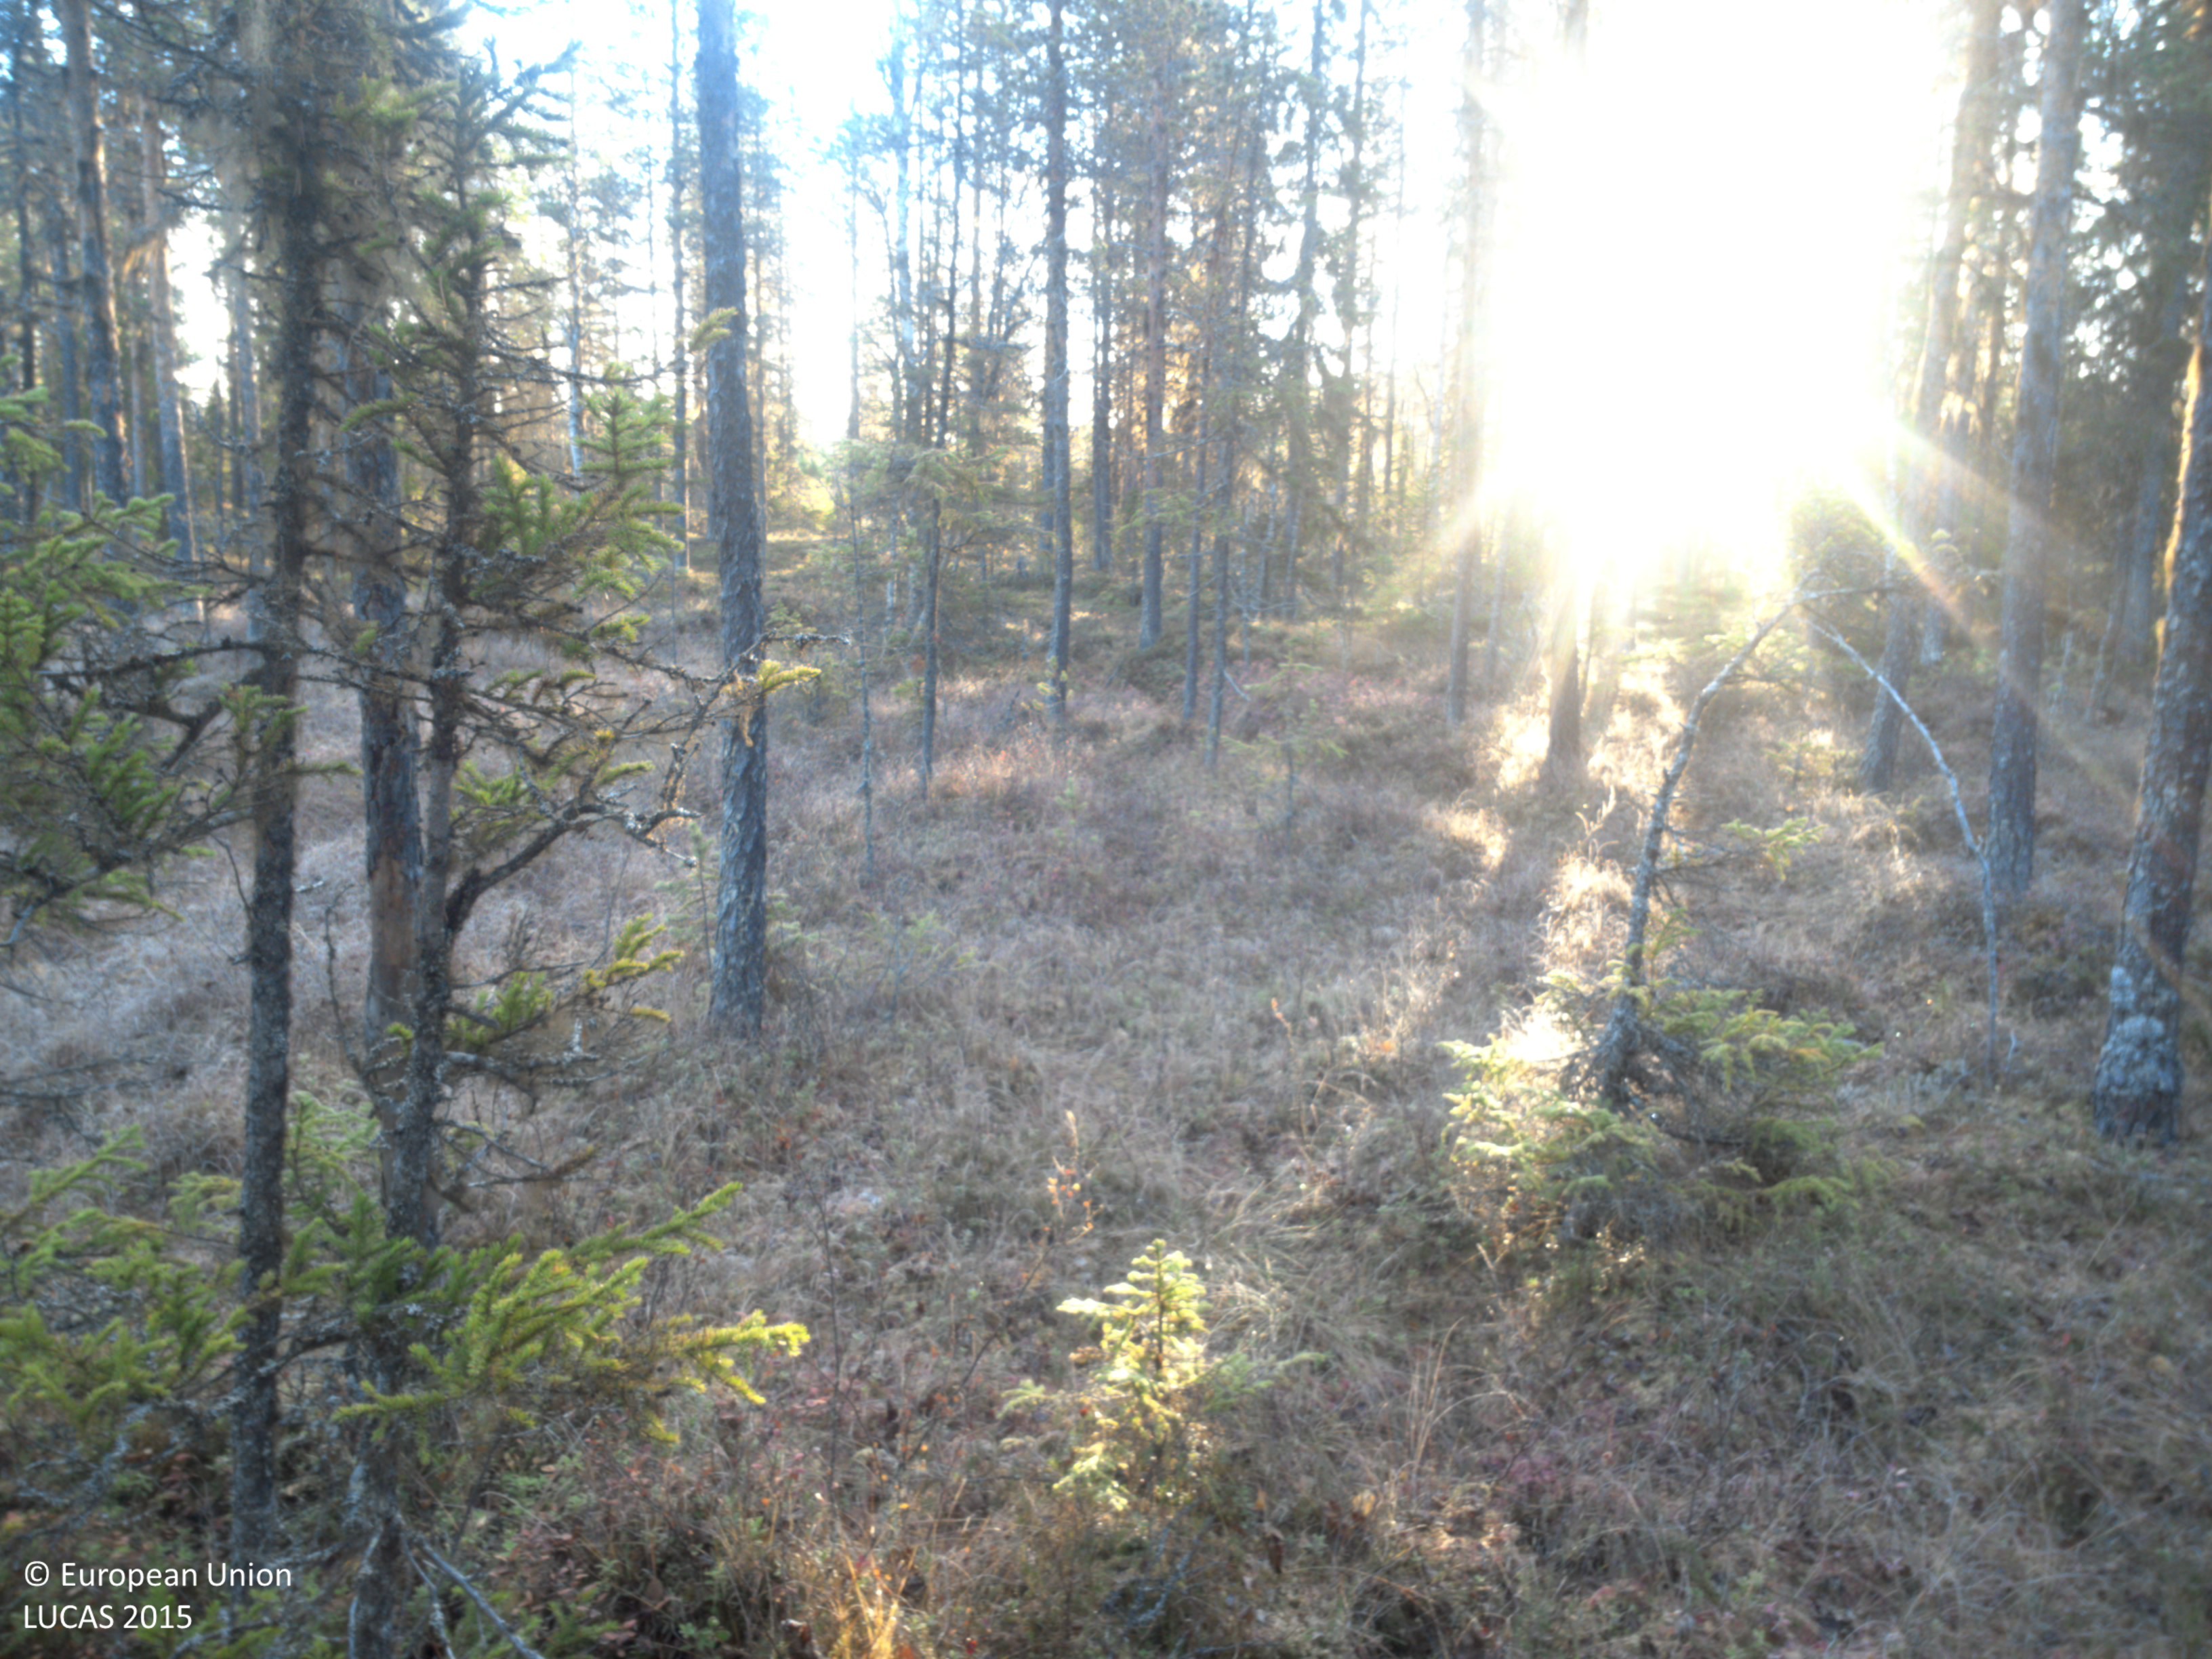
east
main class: Woodland
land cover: Pine dominated mixed woodland
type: boreal forest
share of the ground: 50 - 75 %
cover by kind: coniferous forest trees 35 %, shrubs 30 %, broadleaved forest trees 15 %, herbaceous plants 15 %, lichens and mosses 5 %
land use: Forestry
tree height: > 5 m
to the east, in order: Pine dominated mixed woodland; Pine dominated coniferous woodland; Pine dominated mixed woodland; Spruce dominated mixed woodland; Pine dominated coniferous woodland
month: October
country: SE
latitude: 64.8177
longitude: 18.2854
